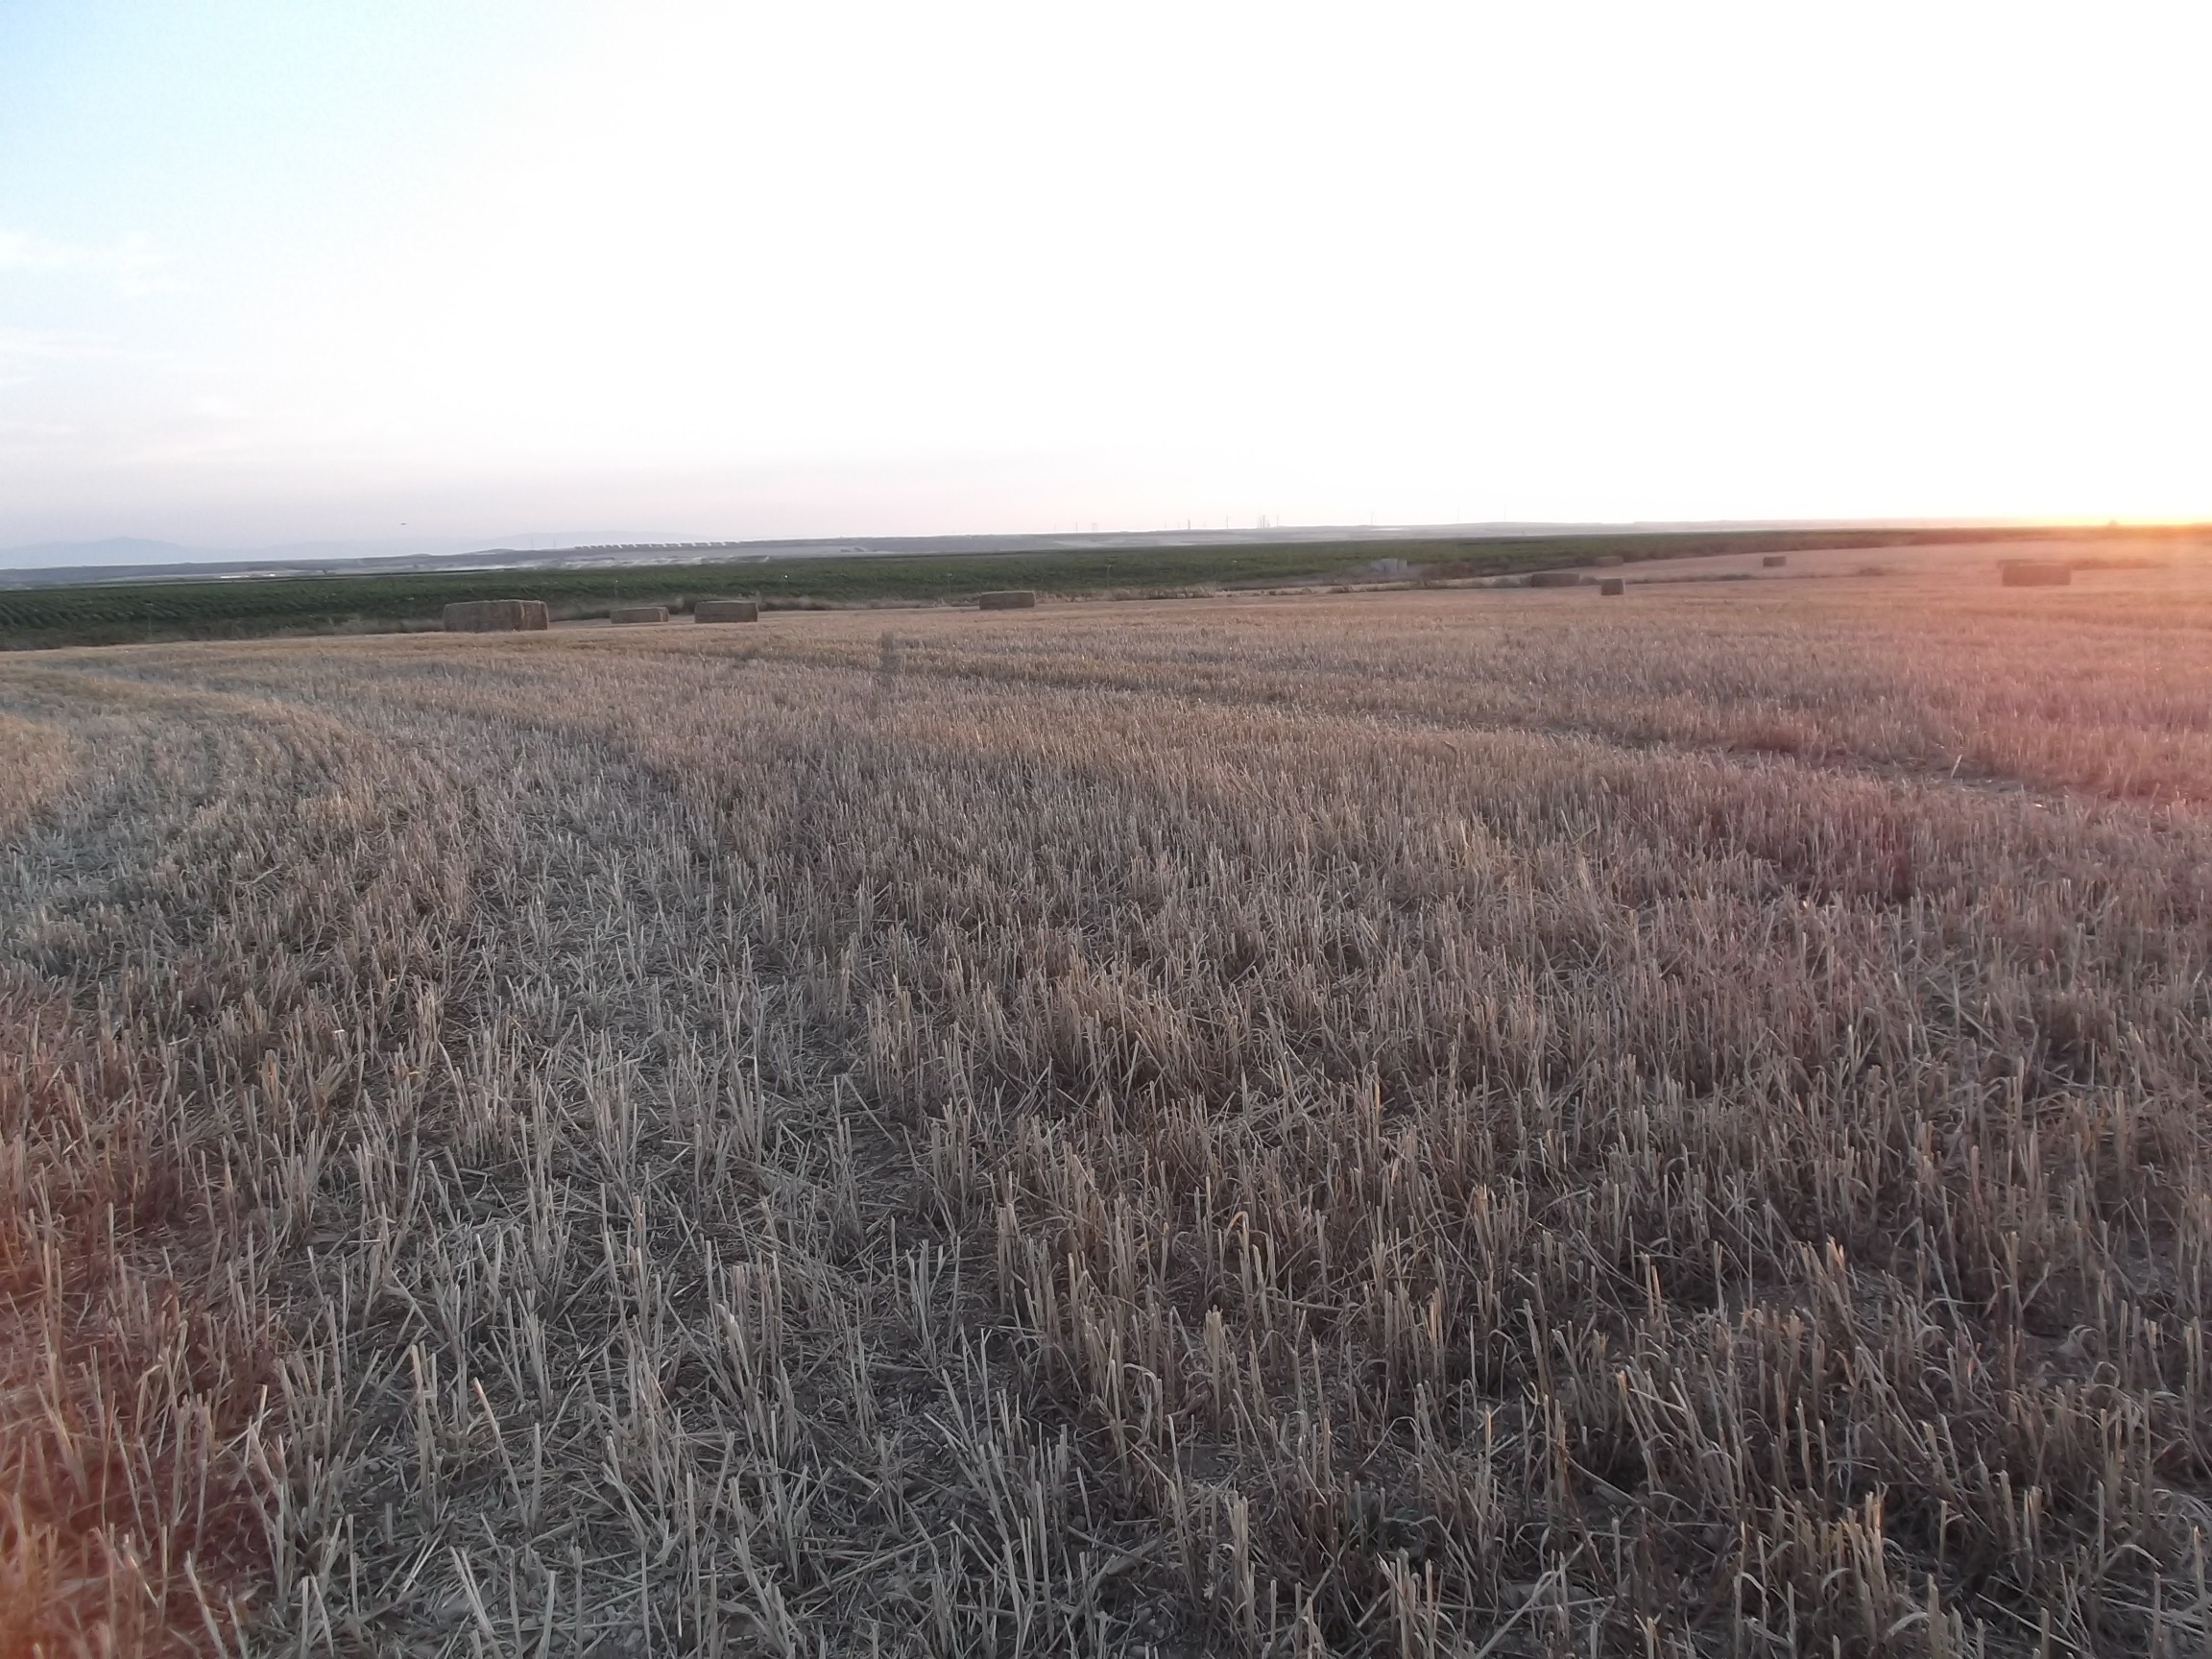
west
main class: Cropland
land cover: Common wheat
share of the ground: < 10 %
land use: Agriculture (excluding fallow land and kitchen gardens)
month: July
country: ES
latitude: 42.4412
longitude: -1.5967
